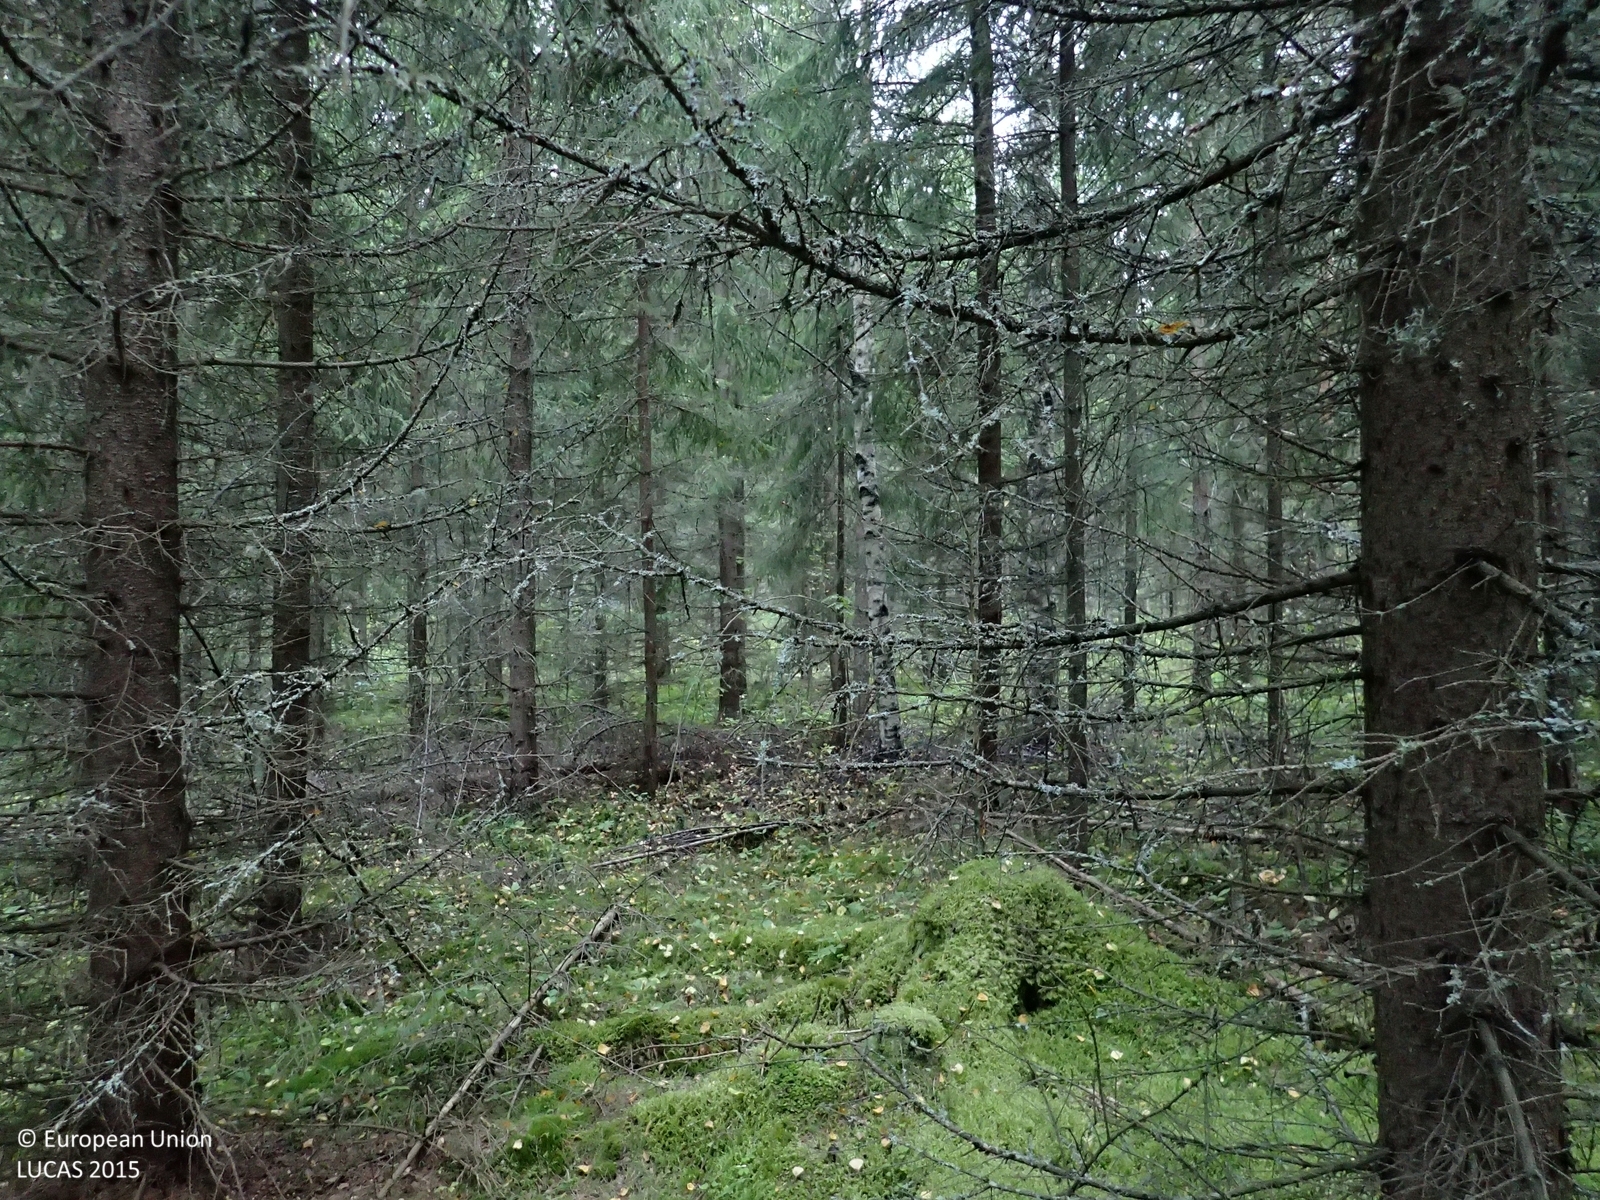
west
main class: Woodland
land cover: Spruce dominated coniferous woodland
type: boreal forest
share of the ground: > 75 %
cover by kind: coniferous forest trees 75 %, lichens and mosses 10 %, broadleaved forest trees 5 %, shrubs 5 %, herbaceous plants 5 %
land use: Forestry
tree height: > 5 m
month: September
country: FI
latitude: 63.0585
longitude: 25.8421
